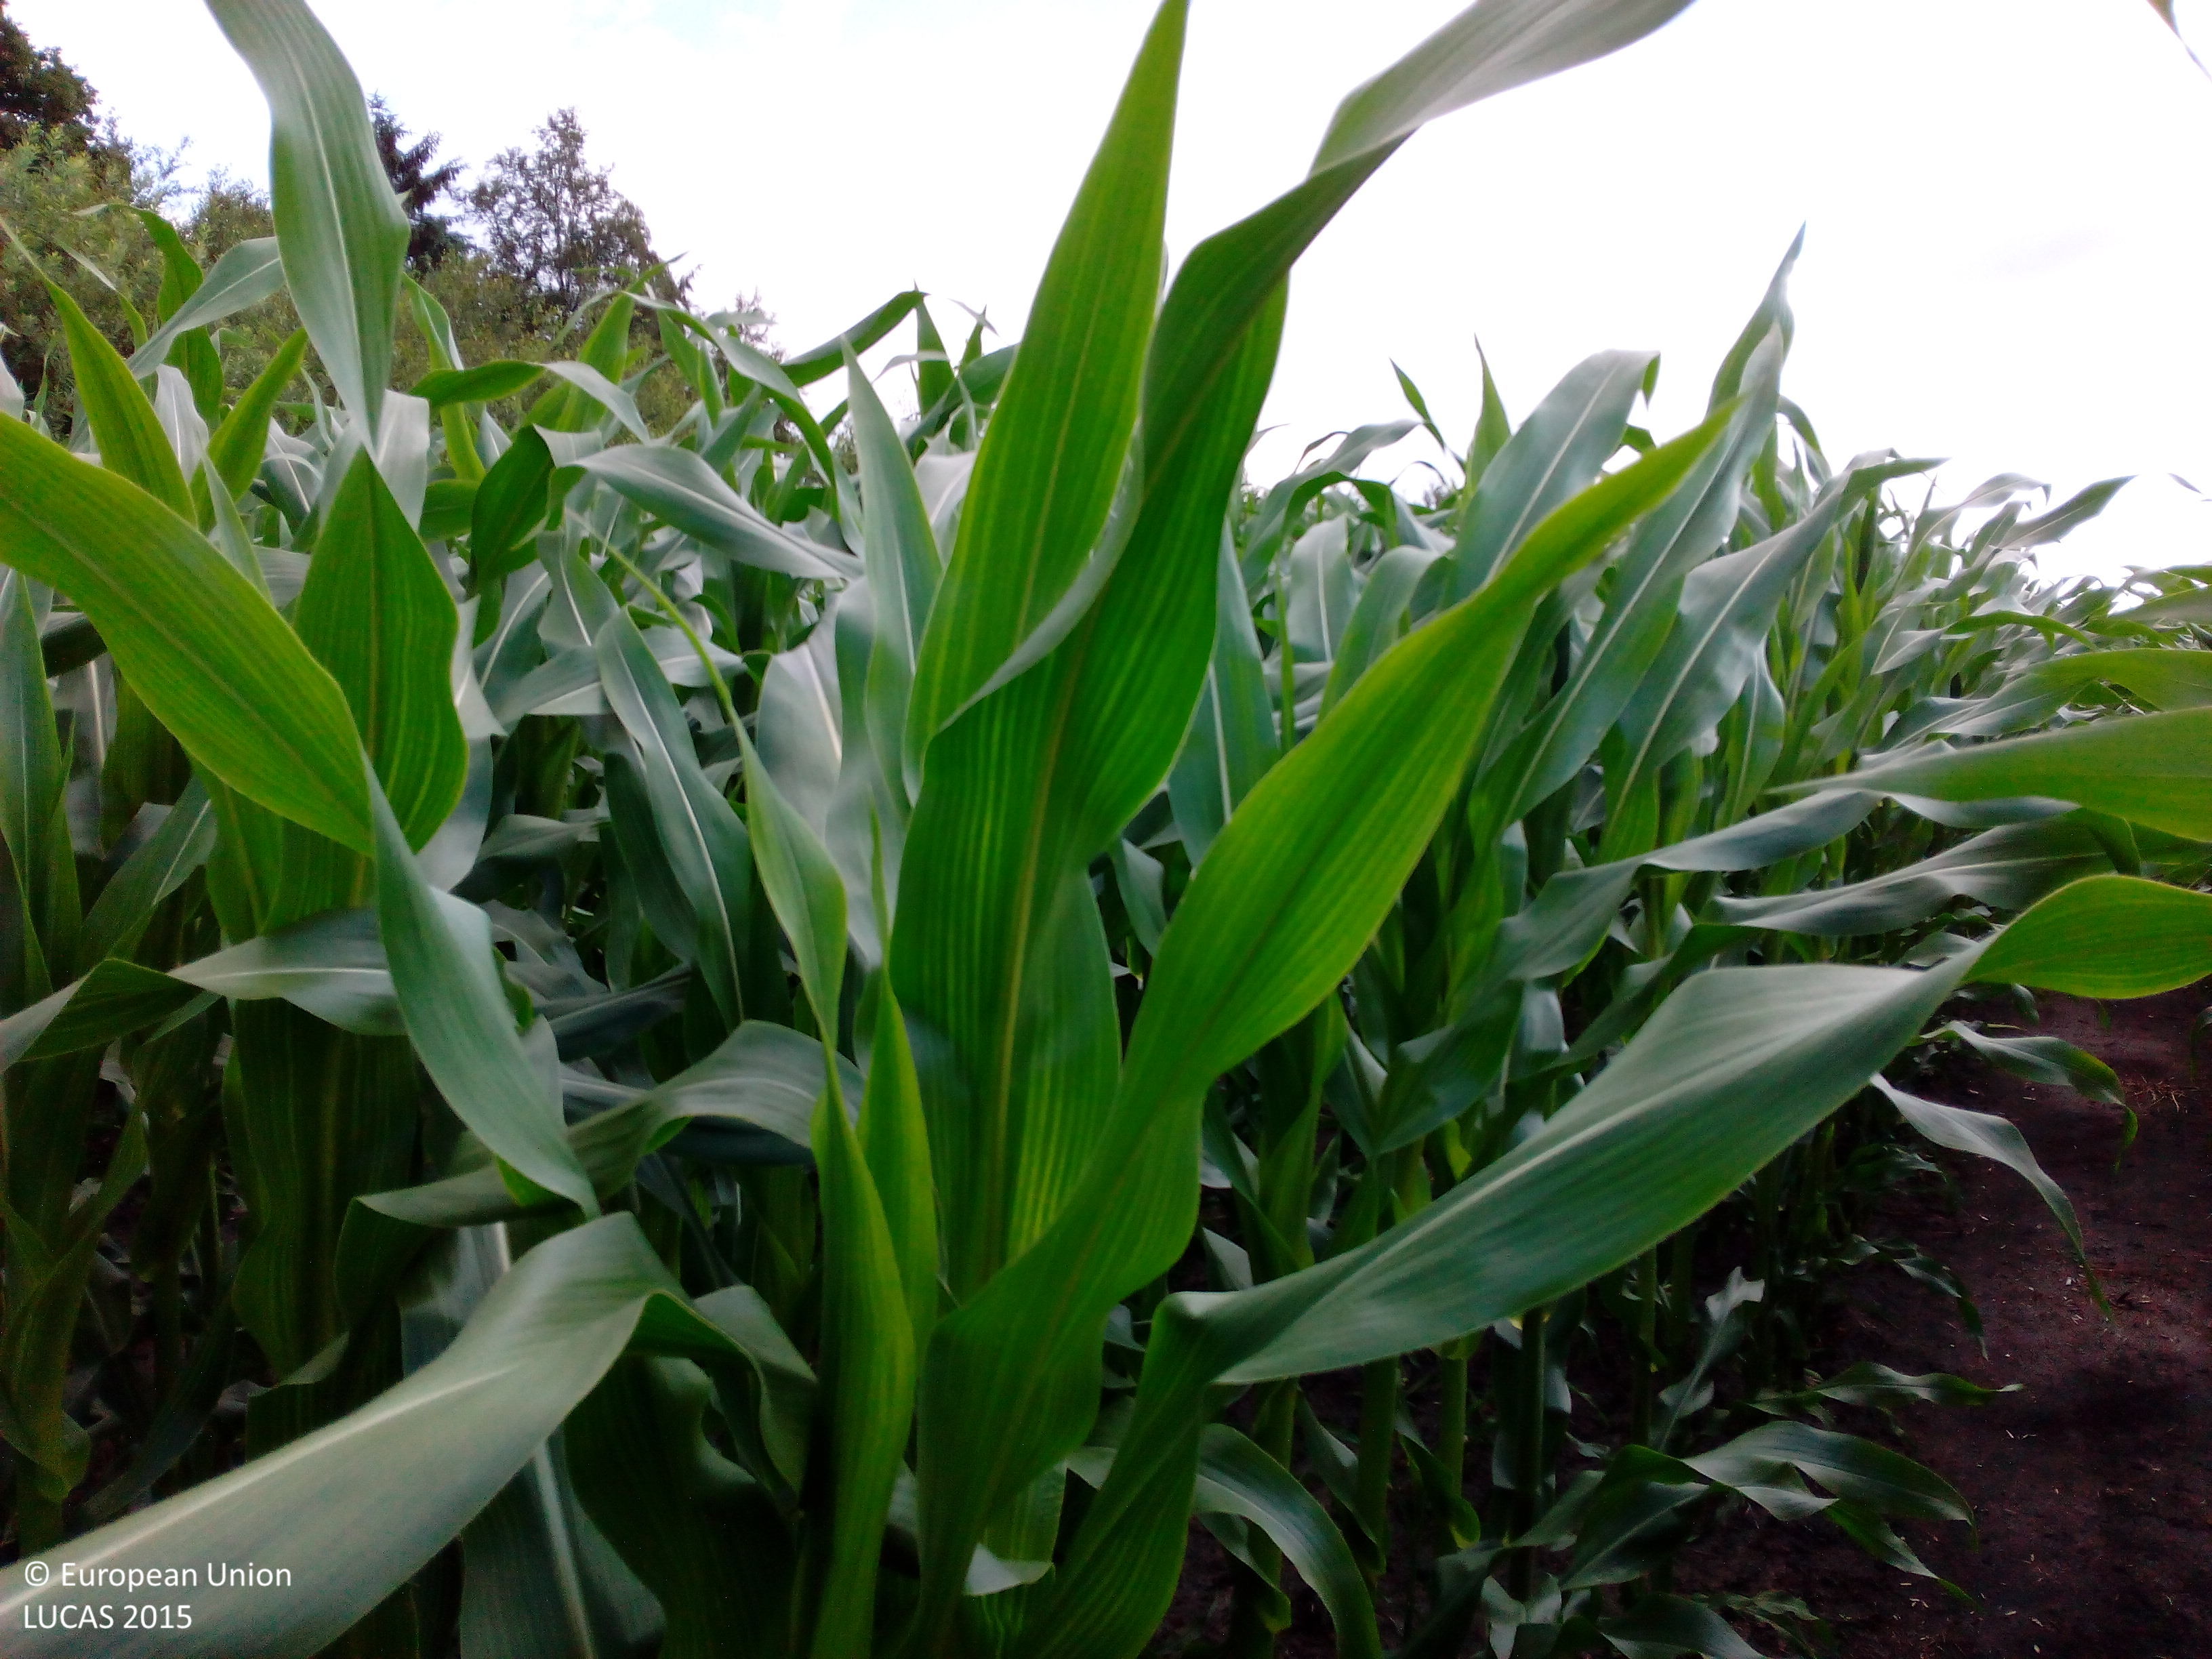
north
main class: Cropland
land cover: Maize
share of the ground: > 75 %
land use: Agriculture (excluding fallow land and kitchen gardens)
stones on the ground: < 10 %
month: July
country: DE
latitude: 53.0257
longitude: 7.9878
